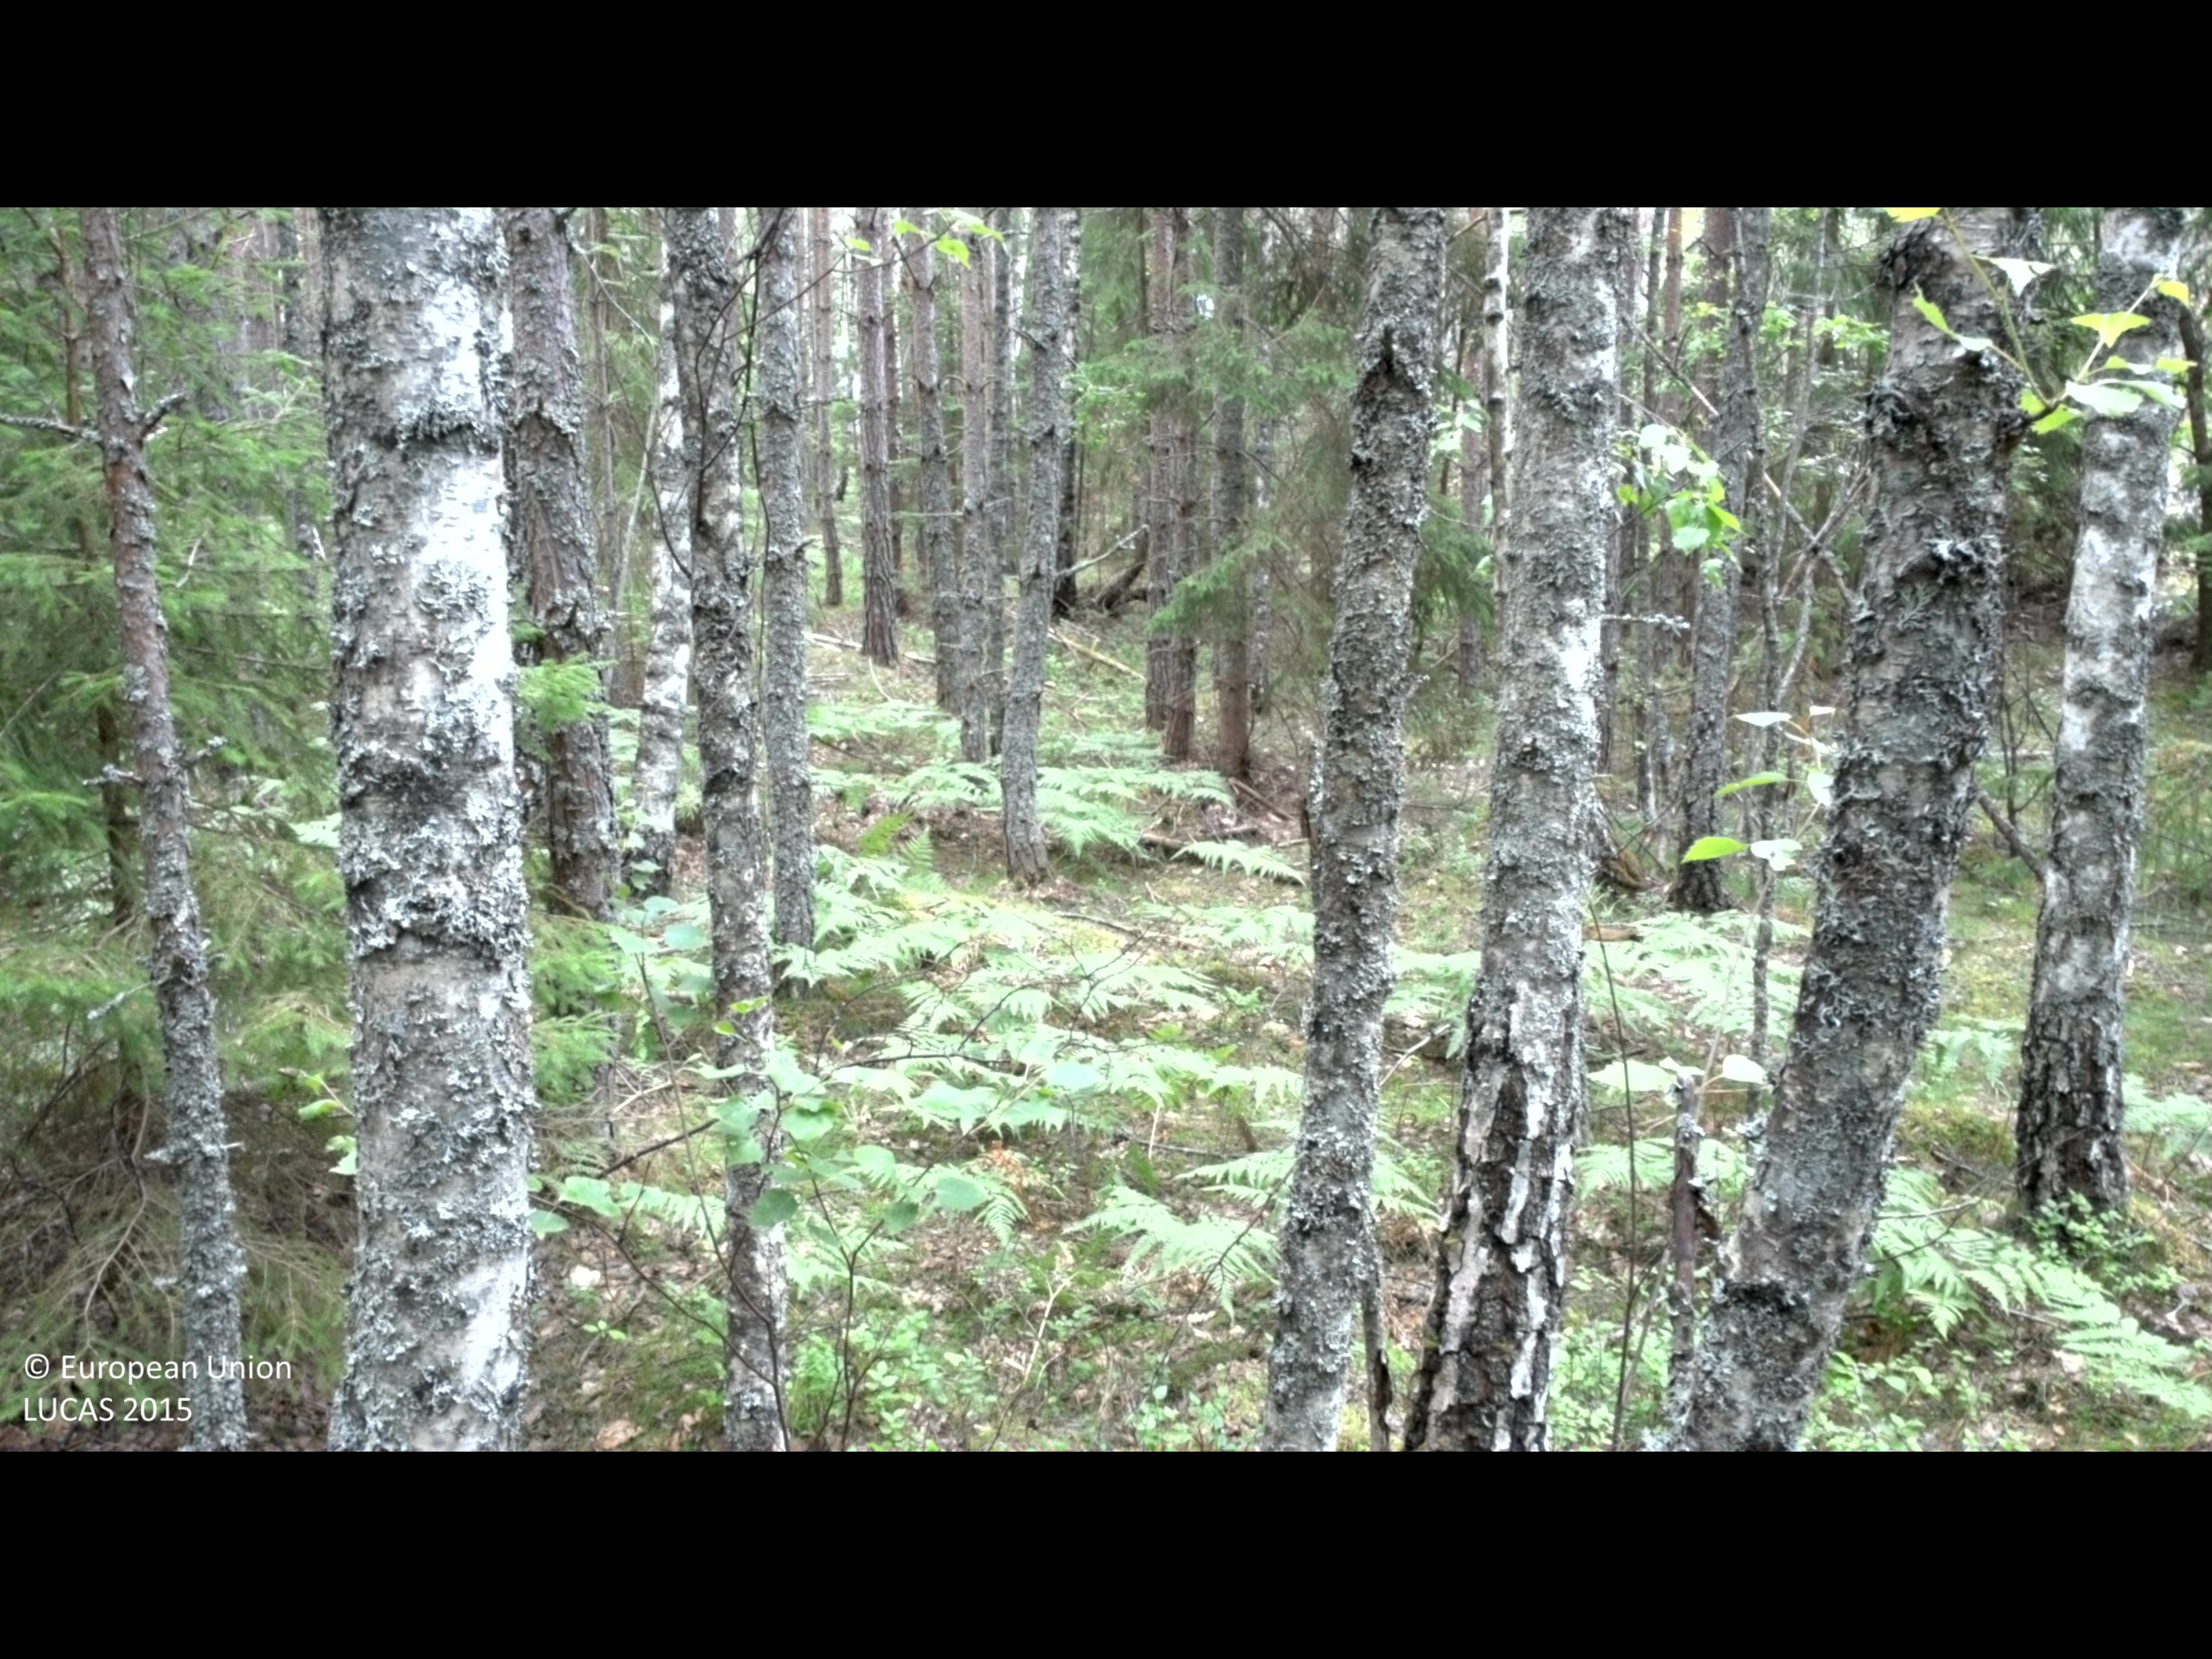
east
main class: Woodland
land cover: Pine dominated mixed woodland
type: boreal forest
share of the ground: > 75 %
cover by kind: coniferous forest trees 50 %, broadleaved forest trees 30 %, shrubs 10 %, herbaceous plants 5 %, lichens and mosses 5 %
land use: Forestry
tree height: > 5 m
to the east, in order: Pine dominated mixed woodland; Pine dominated coniferous woodland; Other bare soil; Spruce dominated mixed woodland; Other coniferous woodland
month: June
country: SE
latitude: 58.1604
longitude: 16.3360
